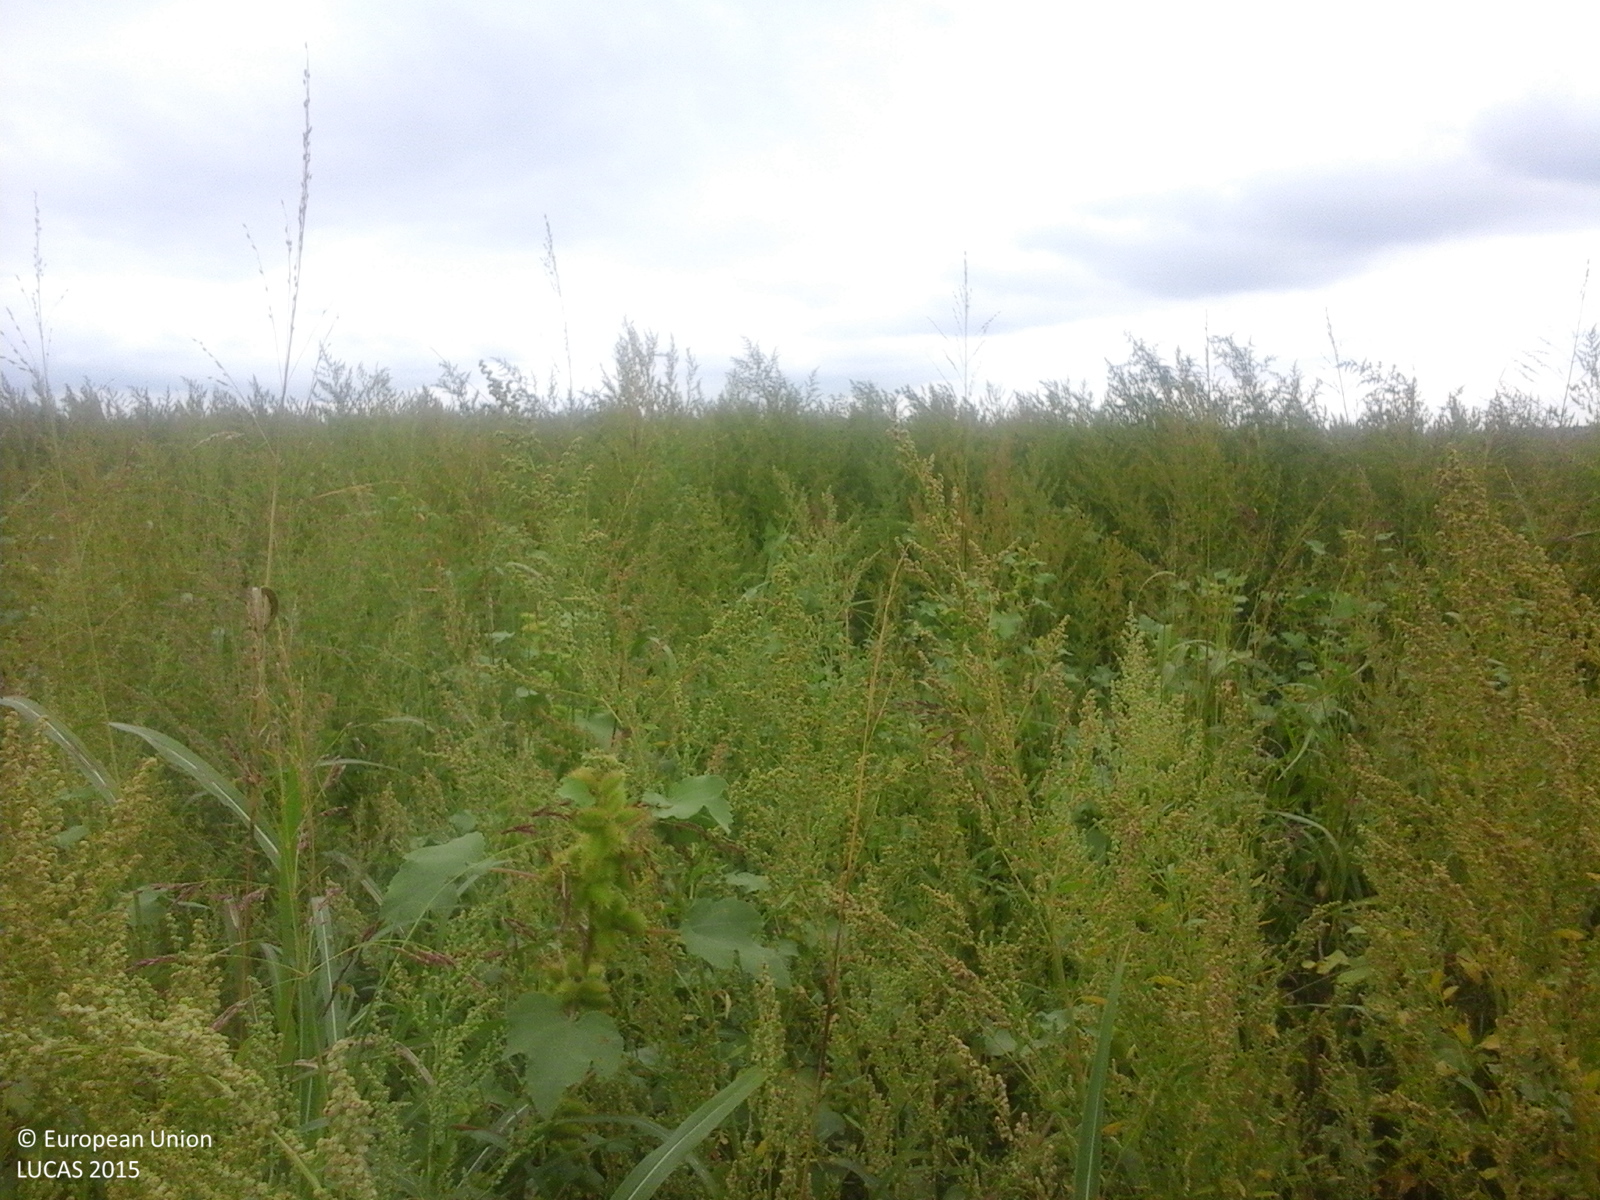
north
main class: Grassland
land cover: Spontaneously vegetated surfaces
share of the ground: > 75 %
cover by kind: herbaceous plants 100 %
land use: Agriculture (excluding fallow land and kitchen gardens)
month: September
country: RO
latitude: 47.3201
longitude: 21.9150
